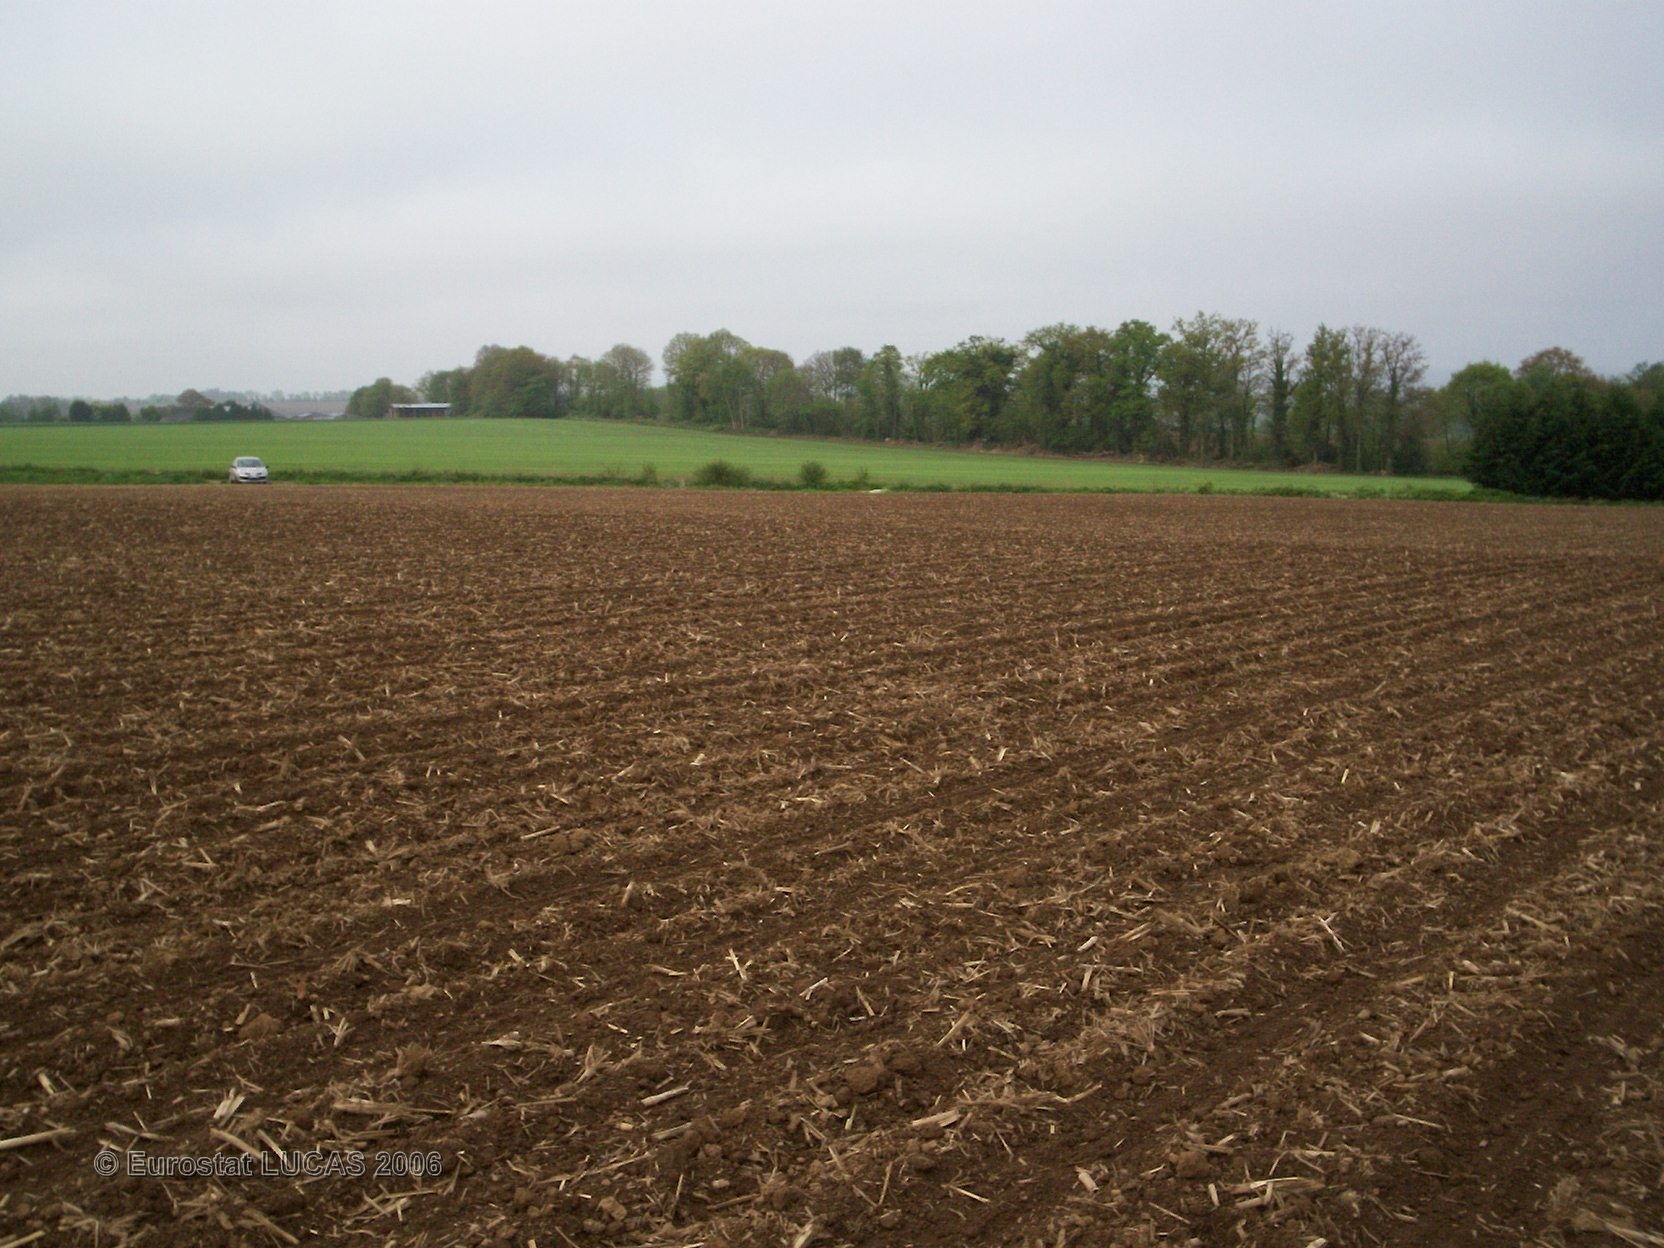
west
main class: Cropland
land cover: Maize
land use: Agriculture (excluding fallow land and kitchen gardens)
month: May
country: FR
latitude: 48.1297
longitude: -2.9529
